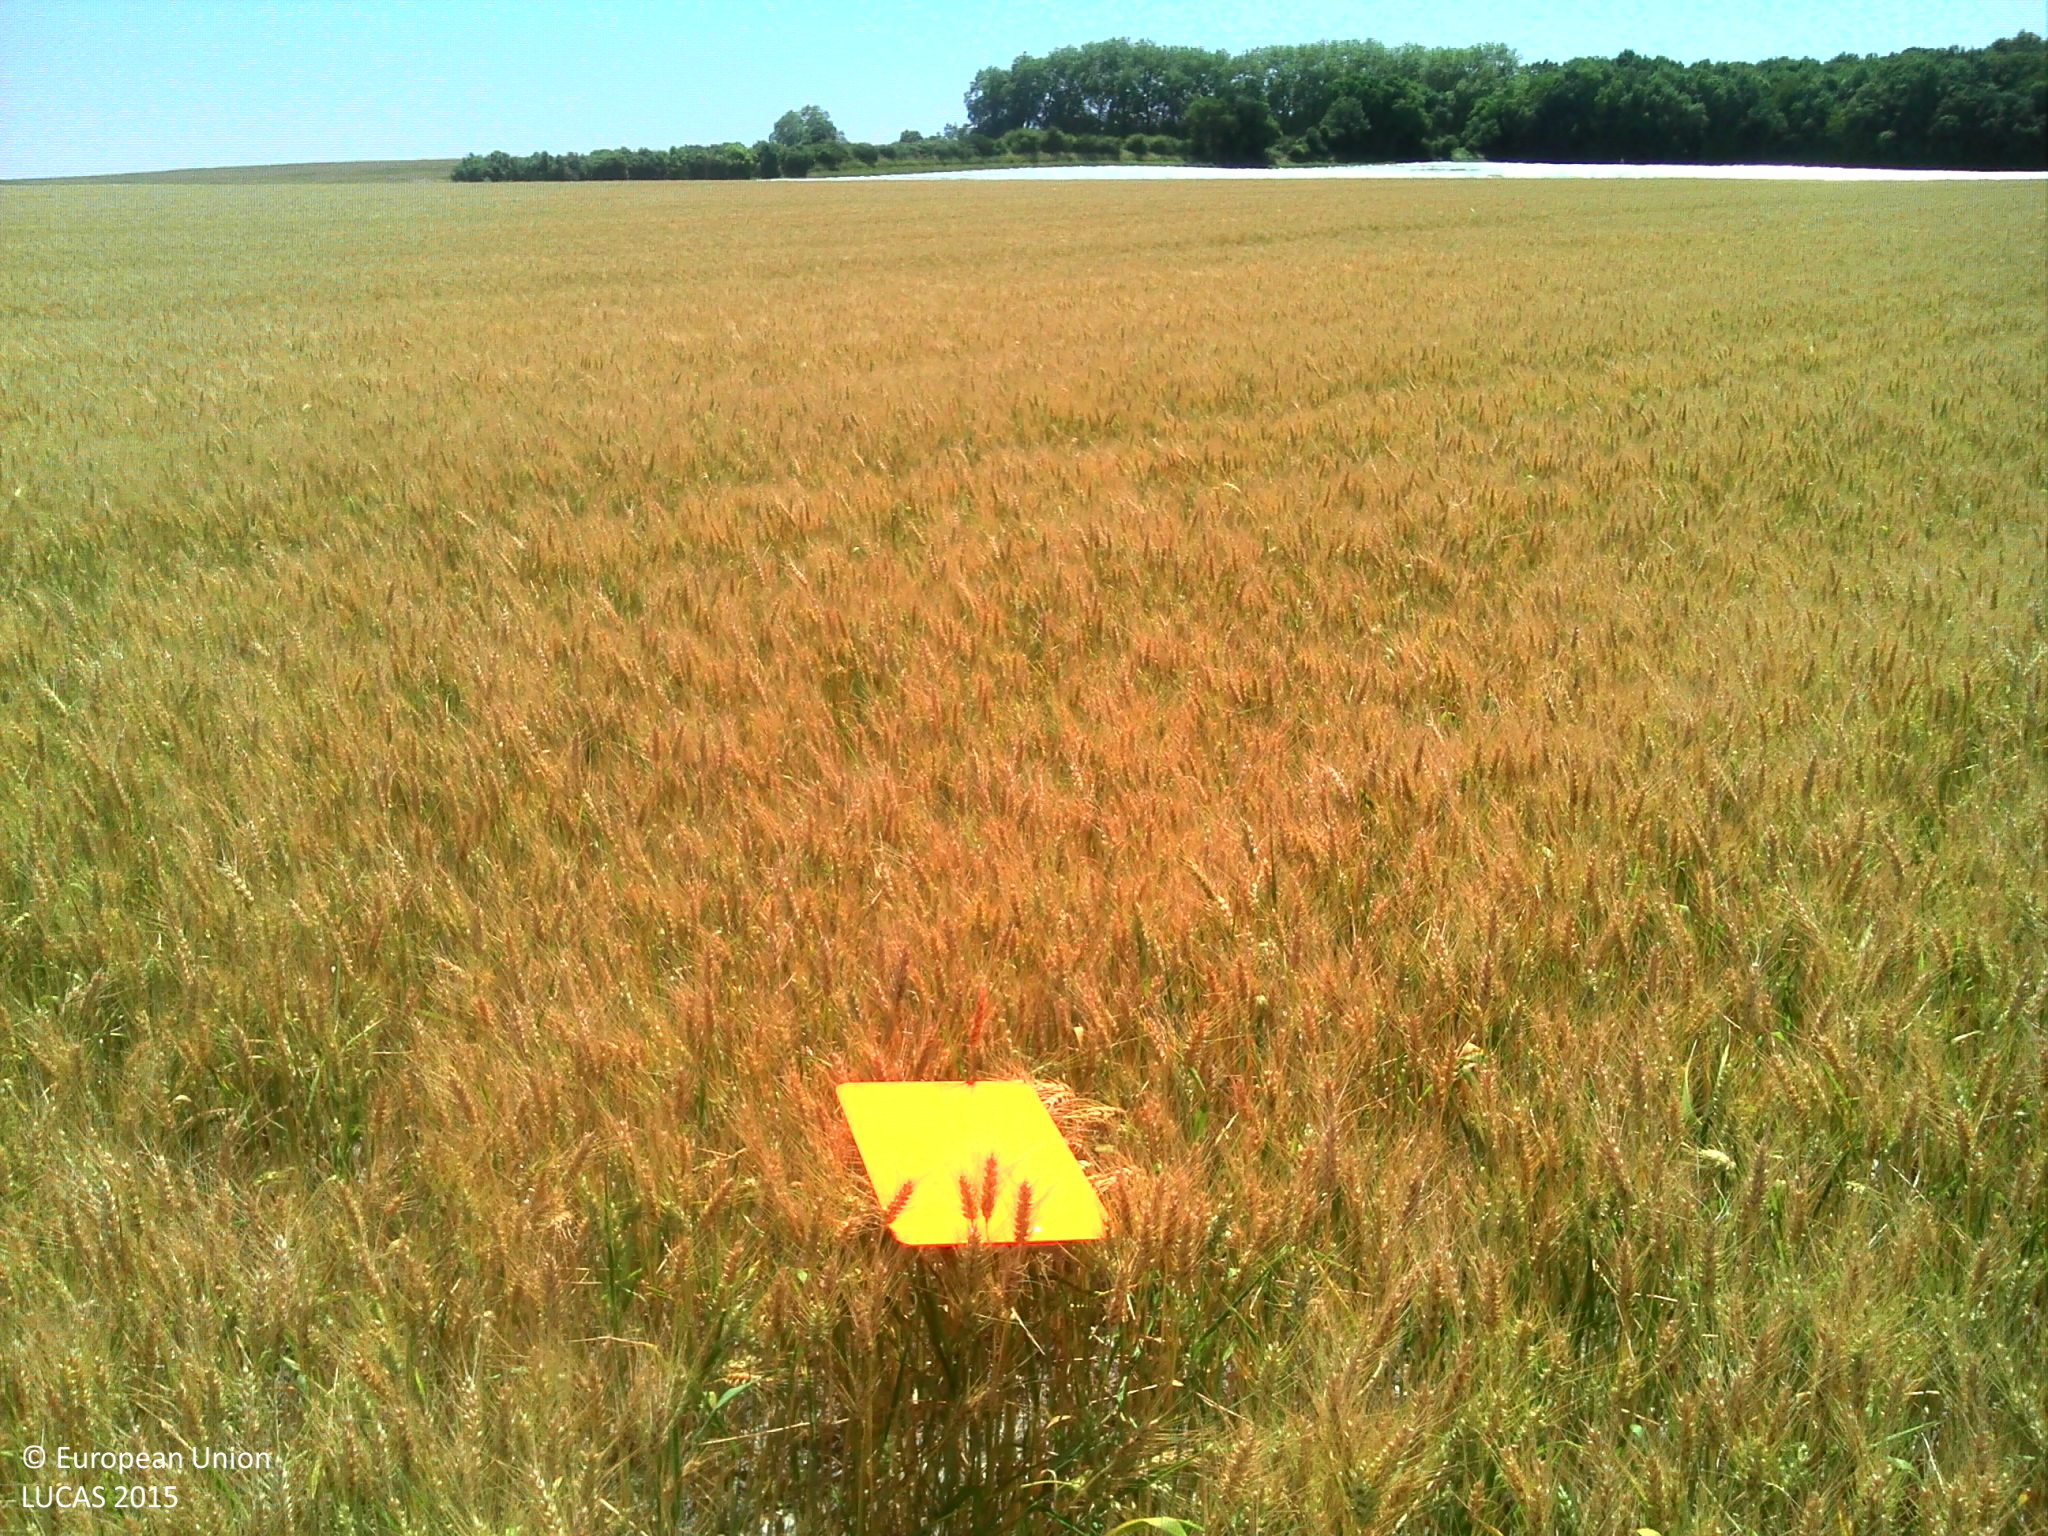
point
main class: Cropland
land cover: Durum wheat
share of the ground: > 75 %
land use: Agriculture (excluding fallow land and kitchen gardens)
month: June
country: FR
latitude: 45.5613
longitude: -0.8512
